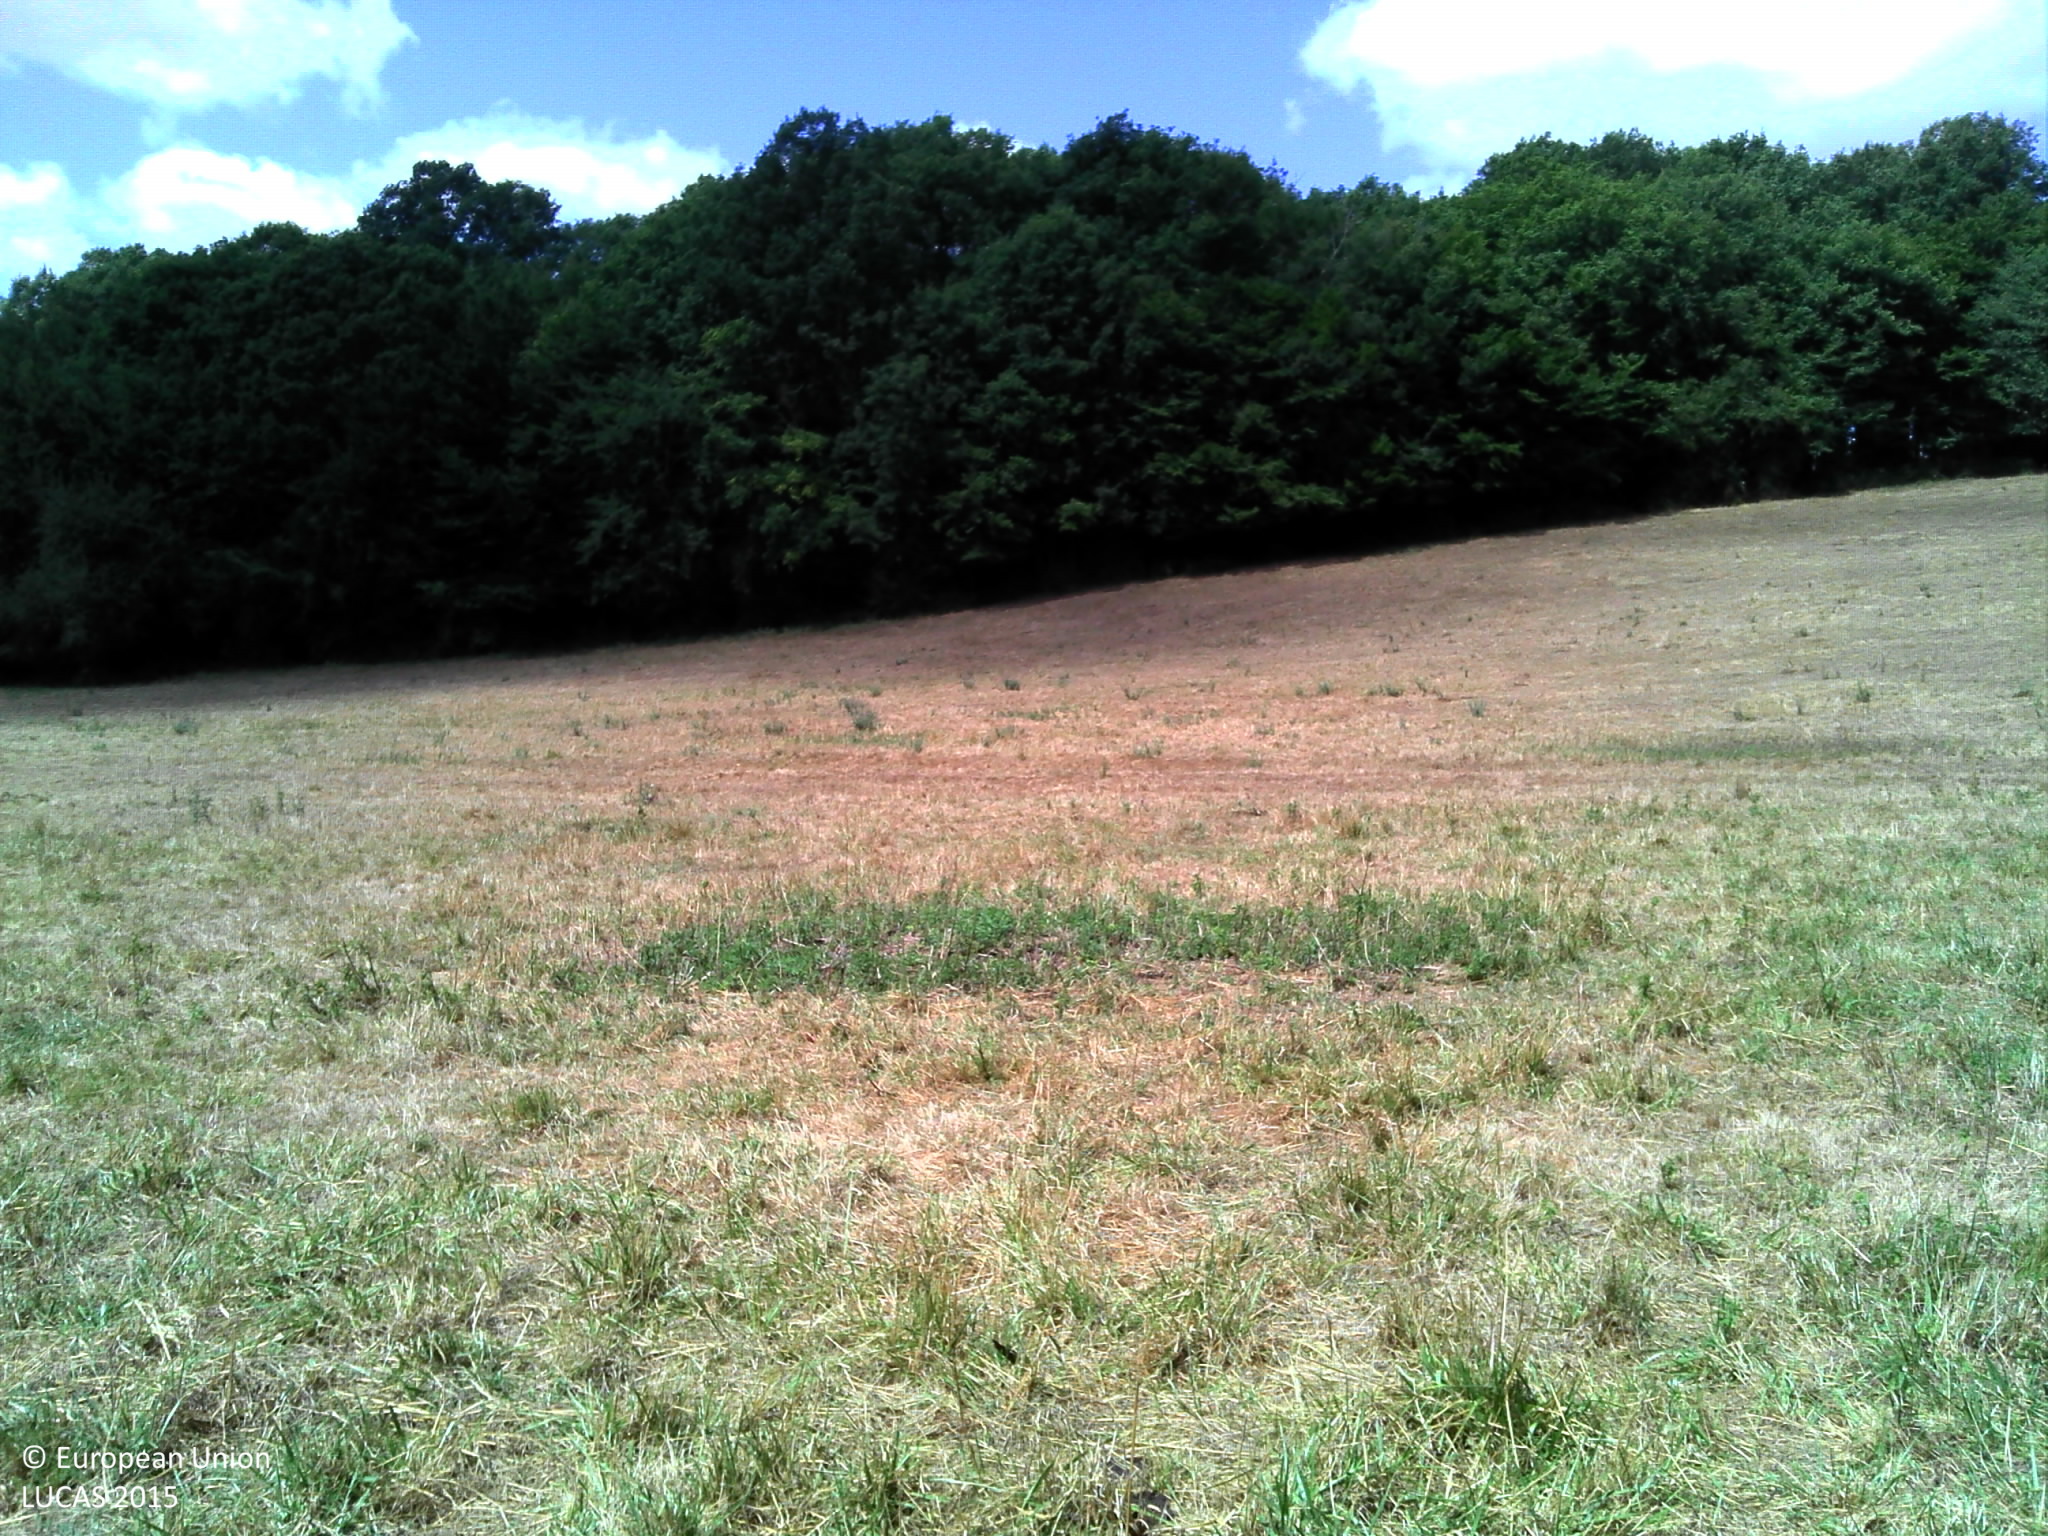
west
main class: Grassland
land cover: Grassland without tree/shrub cover
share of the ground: > 75 %
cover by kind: herbaceous plants 100 %
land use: Agriculture (excluding fallow land and kitchen gardens)
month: July
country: FR
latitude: 47.8651
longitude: 3.1361
